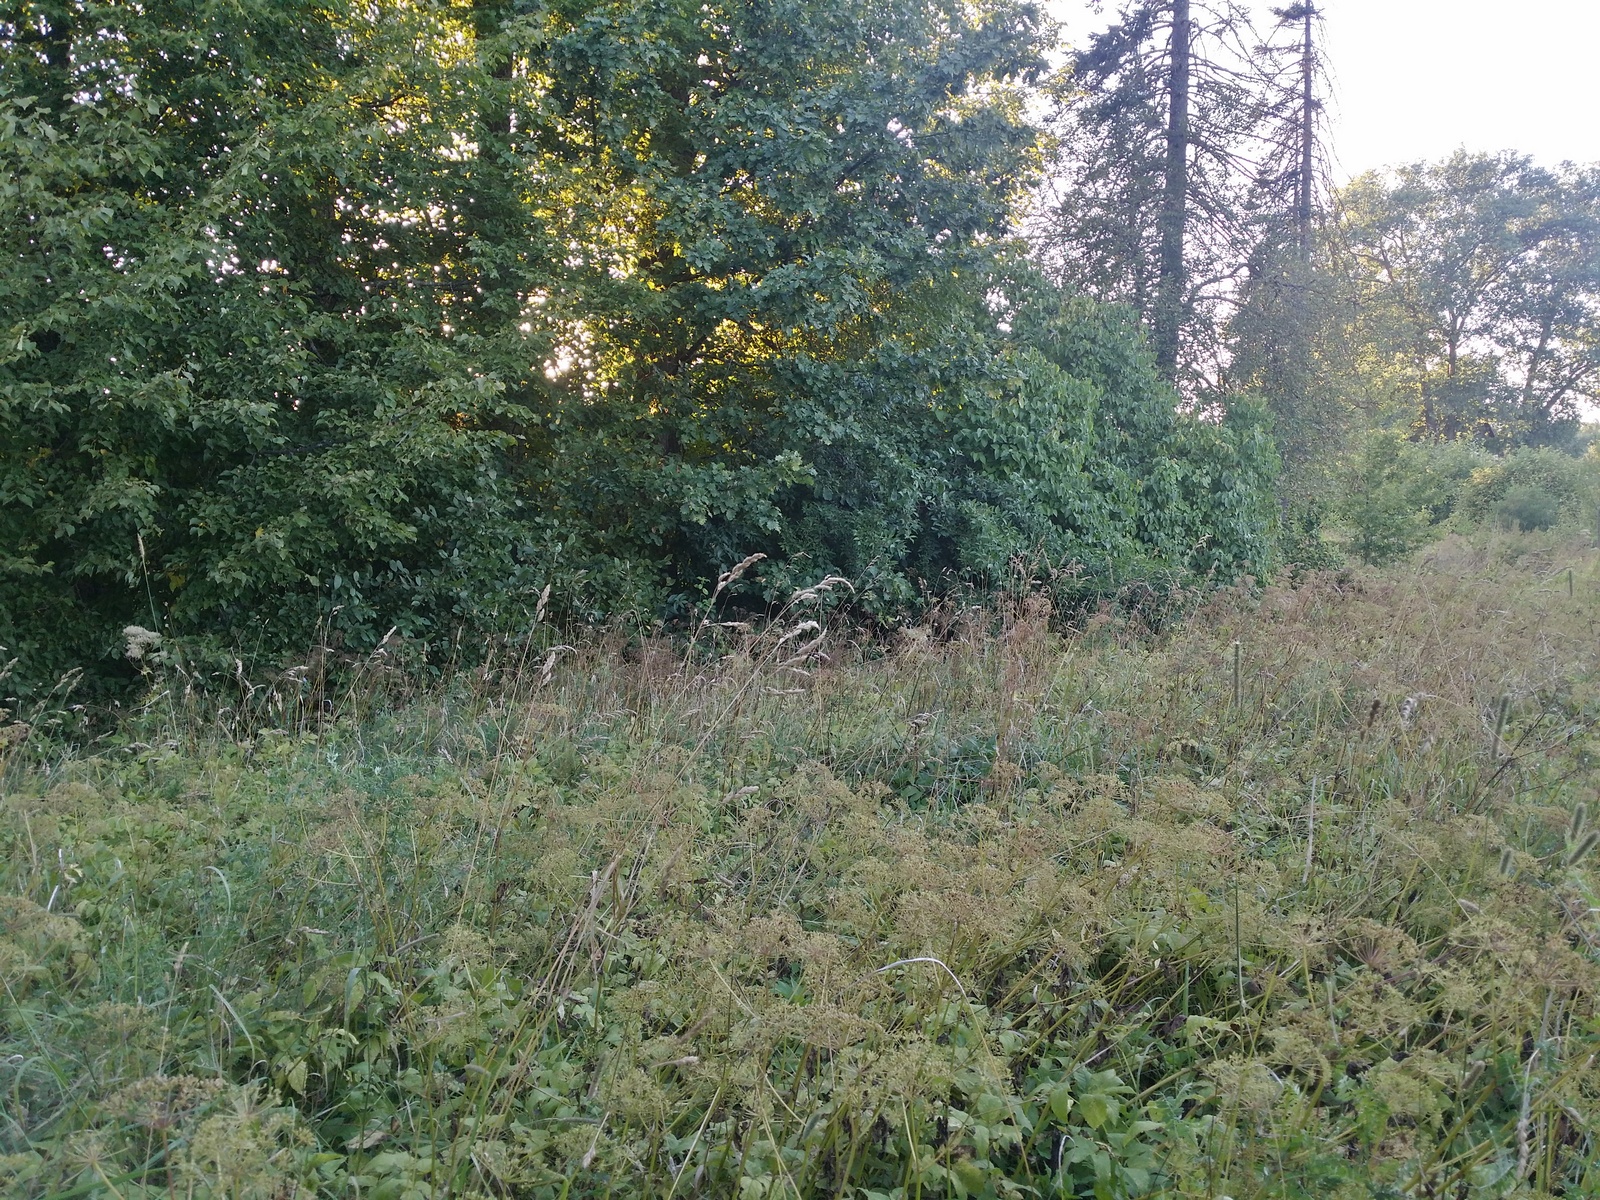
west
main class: Grassland
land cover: Spontaneously vegetated surfaces
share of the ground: > 75 %
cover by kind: herbaceous plants 95 %, shrubs 5 %
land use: Semi-natural and natural areas not in use
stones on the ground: < 10 %
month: August
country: LV
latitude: 57.1543
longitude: 26.7663
